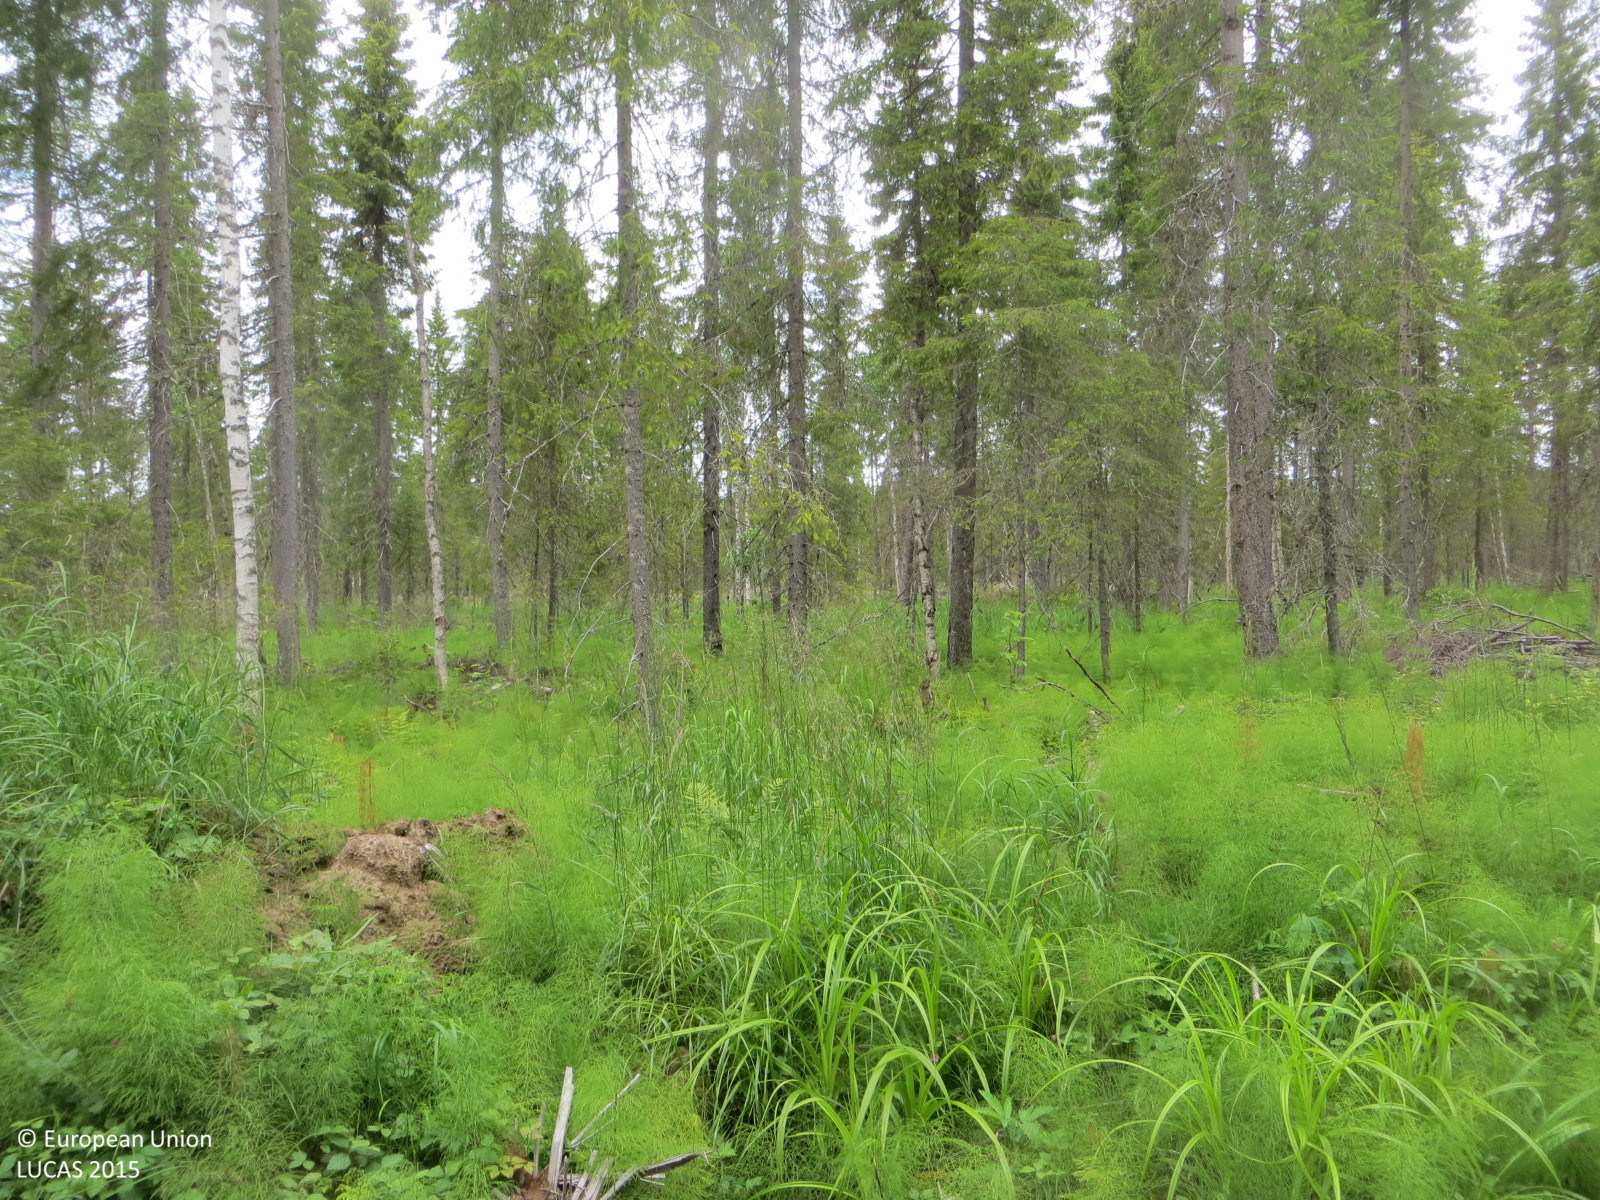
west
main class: Woodland
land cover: Spruce dominated coniferous woodland
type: boreal forest
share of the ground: 50 - 75 %
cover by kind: coniferous forest trees 60 %, shrubs 35 %, broadleaved forest trees 5 %
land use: Forestry
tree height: > 5 m
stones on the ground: < 10 %
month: July
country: FI
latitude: 66.1555
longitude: 23.9393
